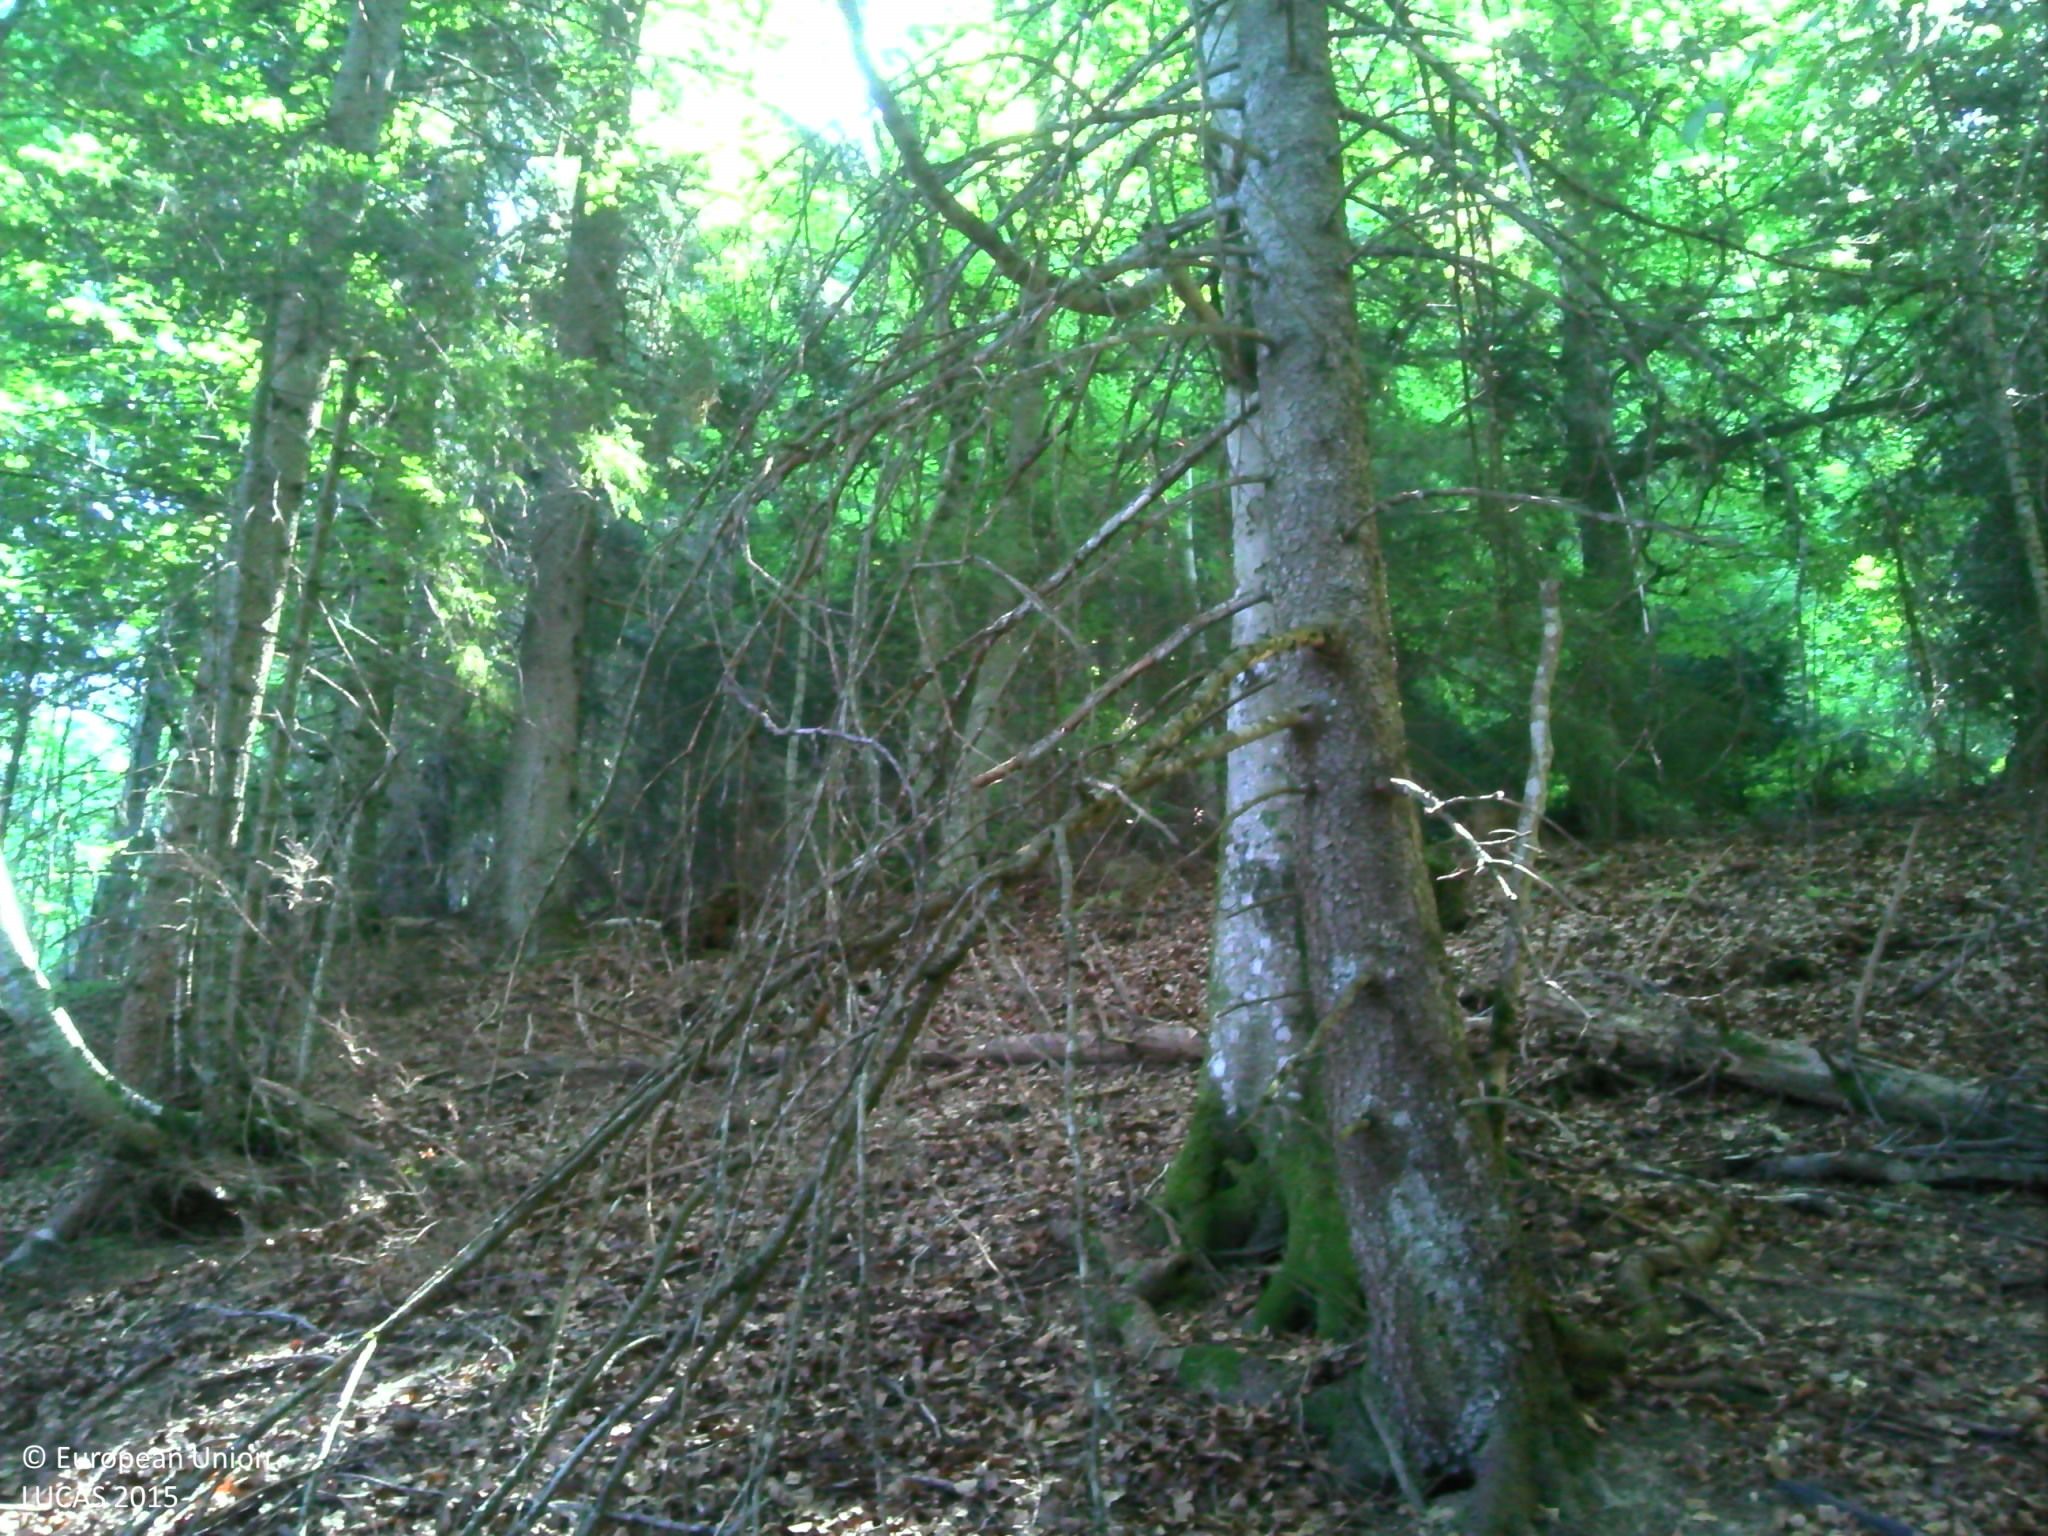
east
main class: Woodland
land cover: Spruce dominated mixed woodland
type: mountainous beech forest
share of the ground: > 75 %
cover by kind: coniferous forest trees 50 %, broadleaved forest trees 30 %, herbaceous plants 15 %, lichens and mosses 5 %
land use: Forestry
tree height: > 5 m
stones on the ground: 10 - 25 %
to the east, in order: Spruce dominated mixed woodland
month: July
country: FR
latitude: 45.7593
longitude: 6.1600
